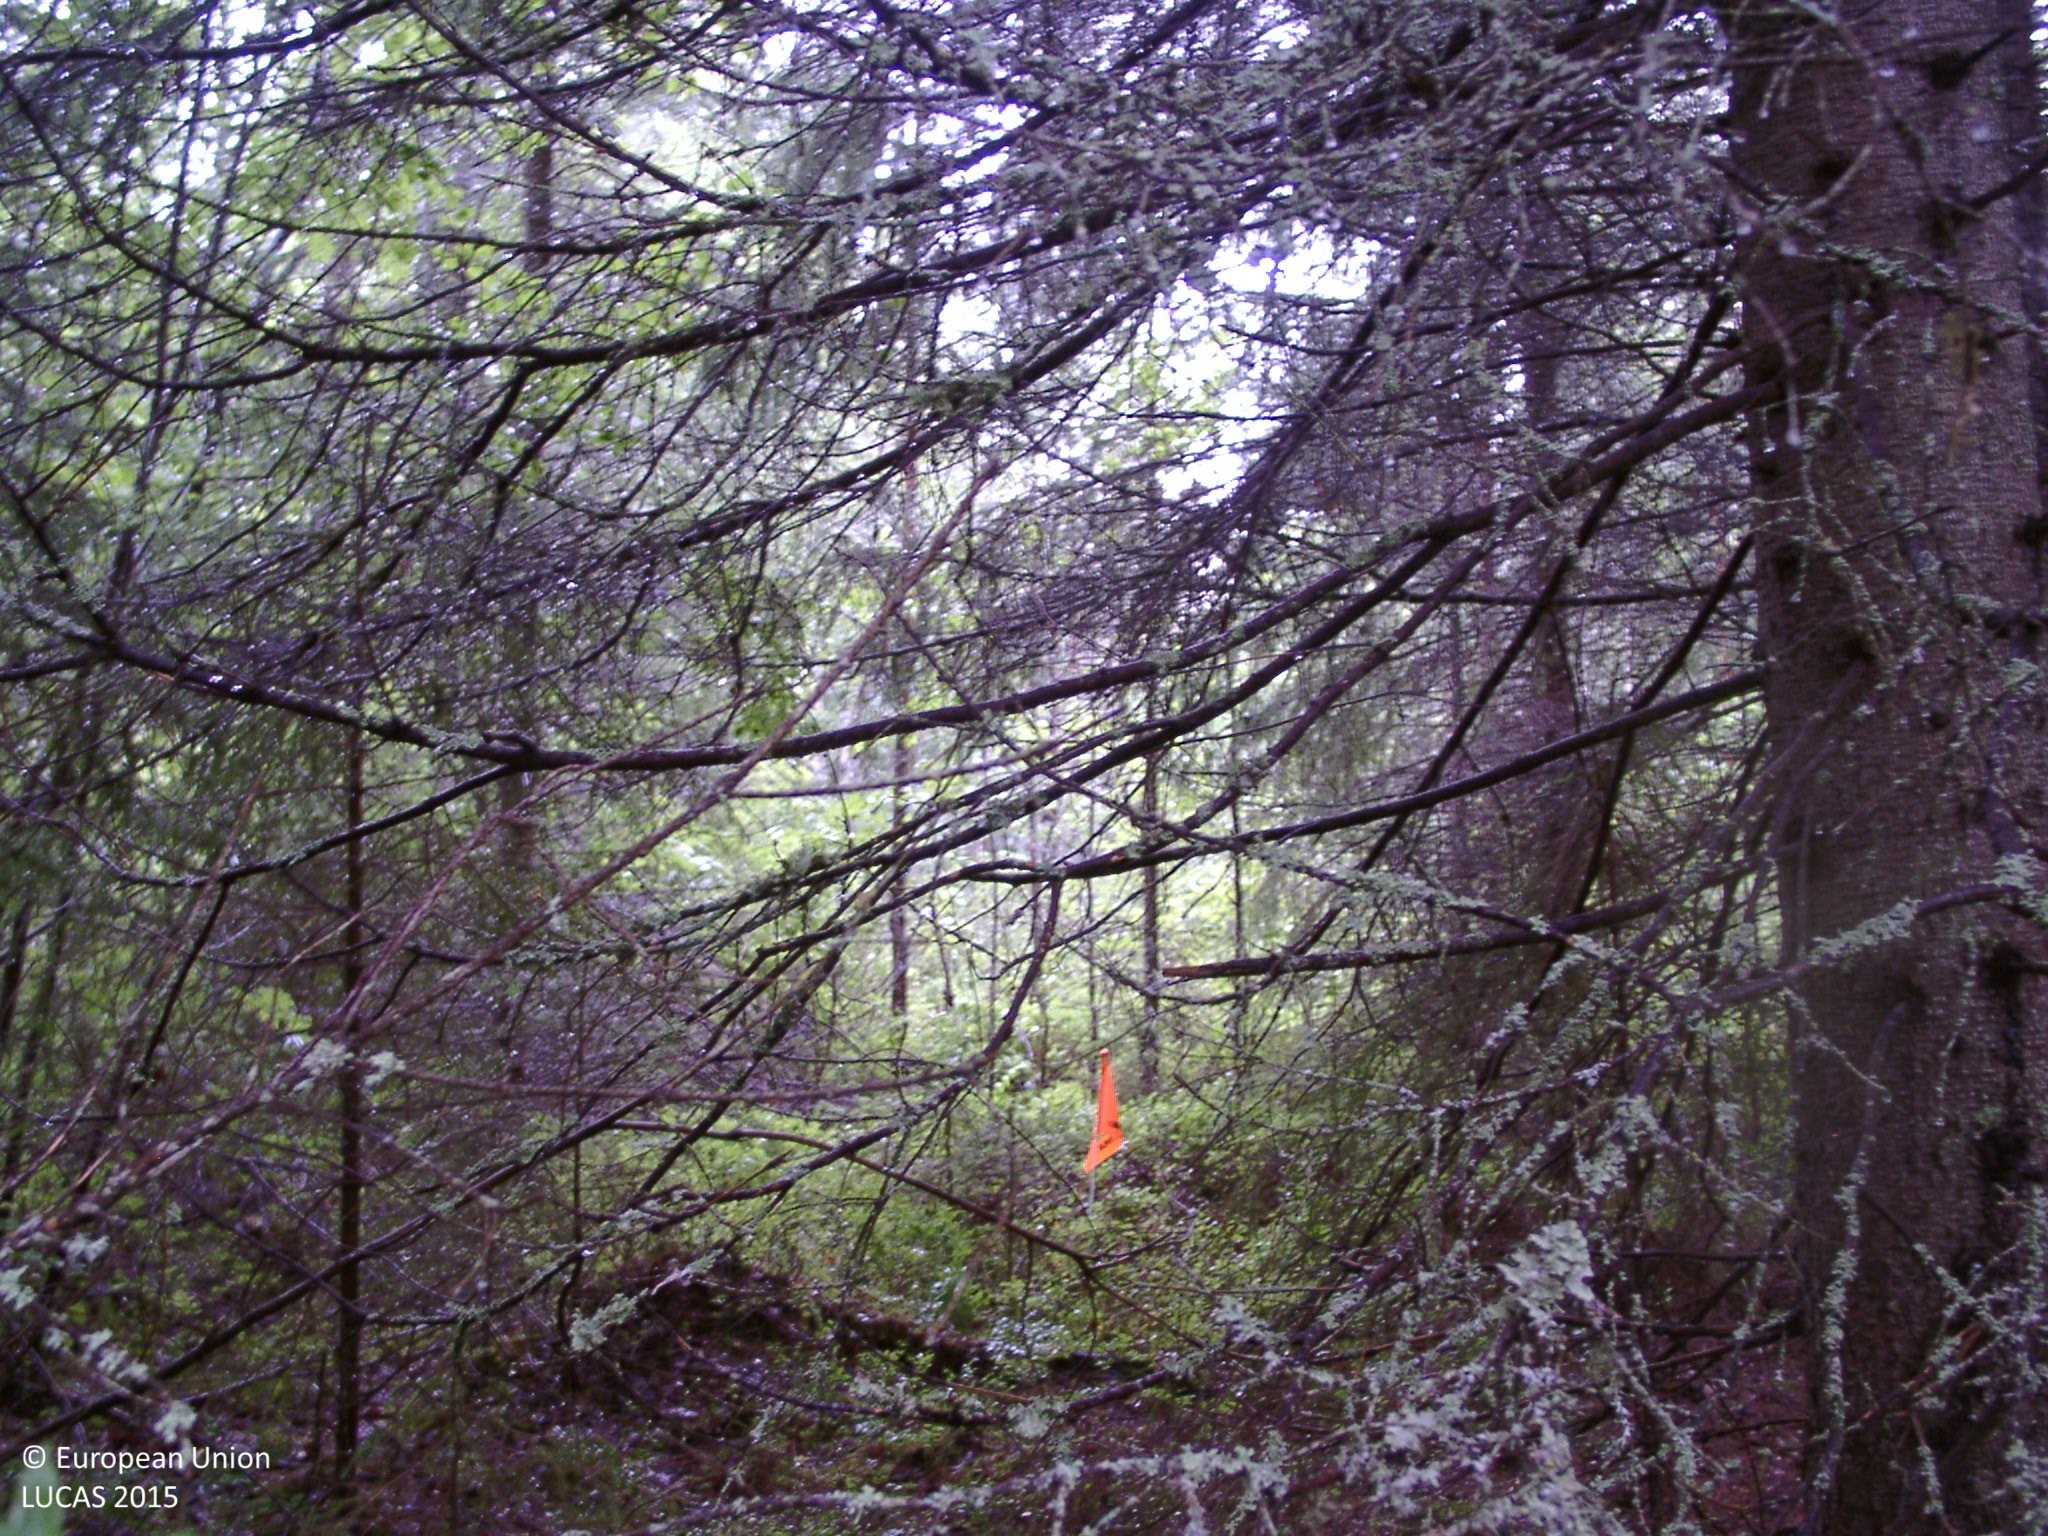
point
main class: Woodland
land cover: Spruce dominated mixed woodland
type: boreal forest
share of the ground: > 75 %
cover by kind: coniferous forest trees 65 %, broadleaved forest trees 25 %, shrubs 10 %
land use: Forestry
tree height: > 5 m
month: July
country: FI
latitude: 62.2806
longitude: 25.5119
